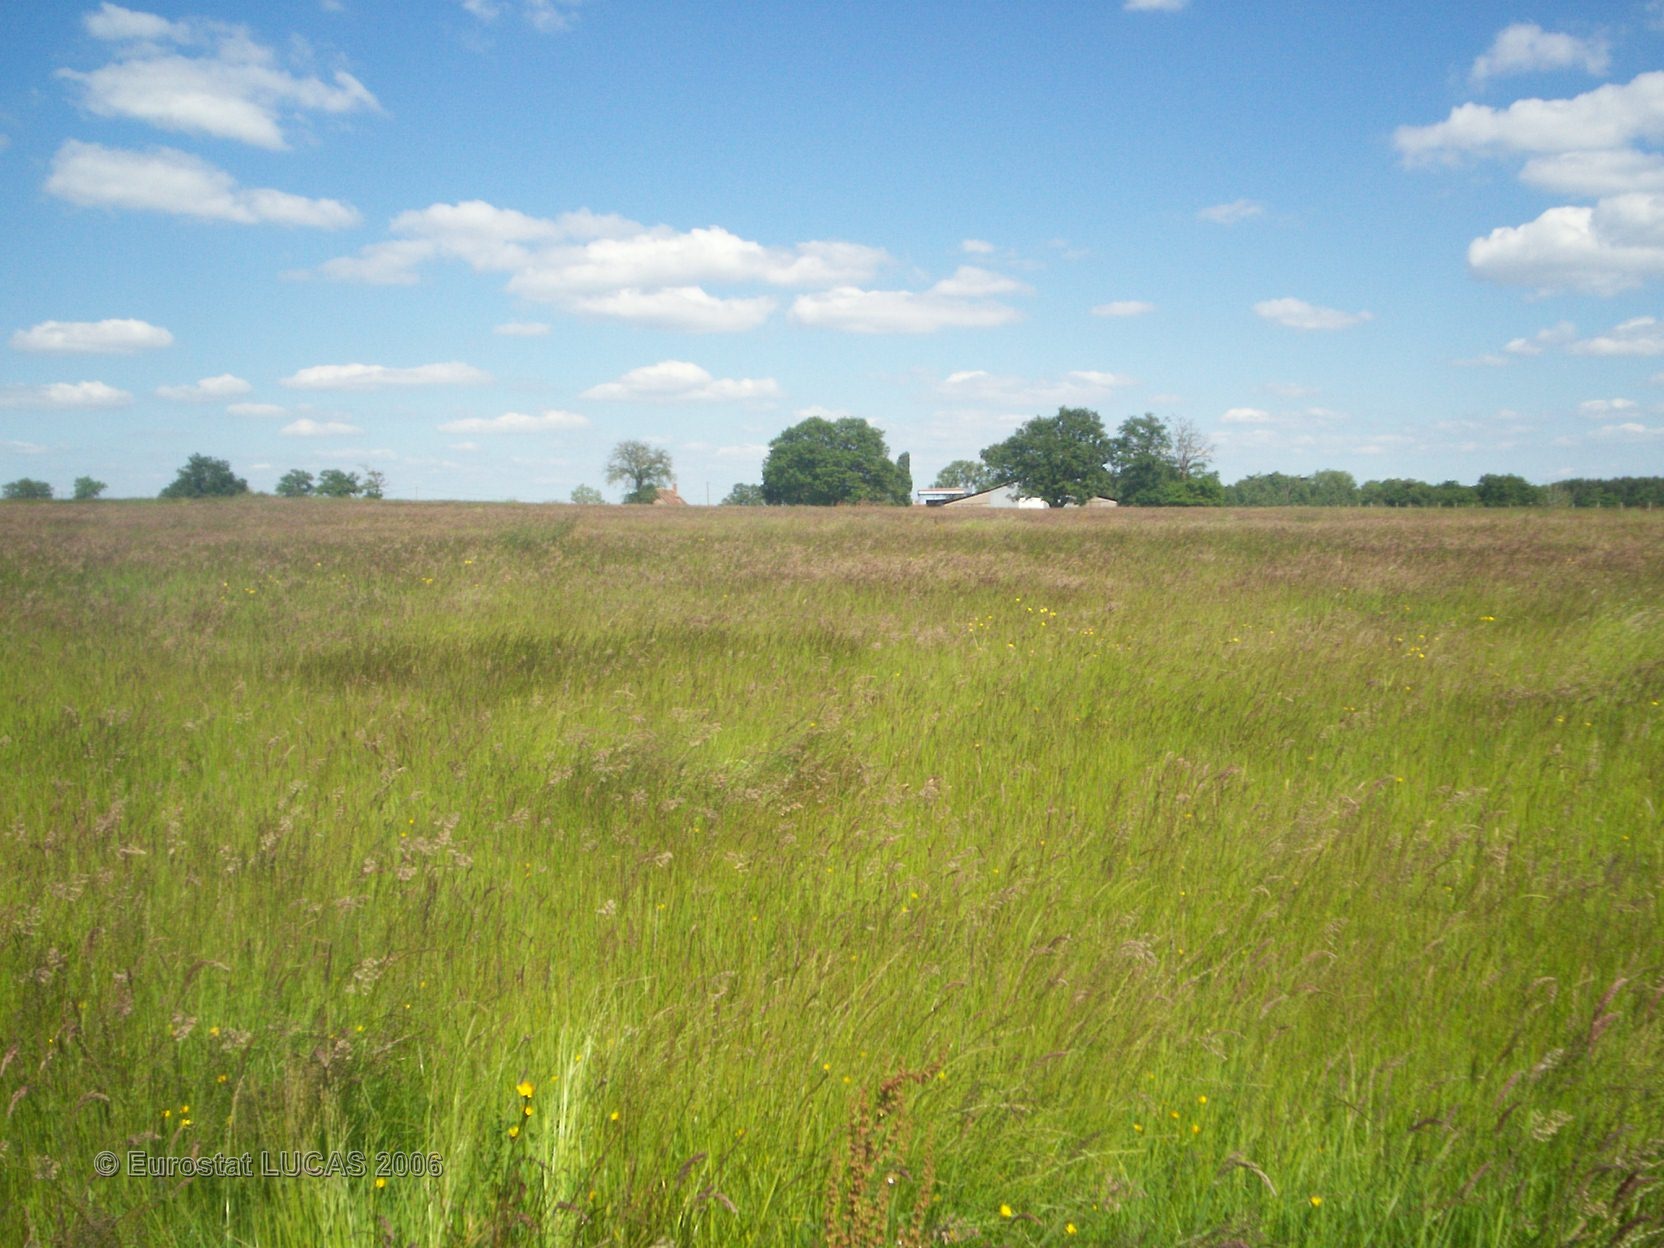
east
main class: Grassland
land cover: Grassland without tree/shrub cover
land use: Agriculture (excluding fallow land and kitchen gardens)
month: June
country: FR
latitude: 46.3109
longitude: 3.1289
